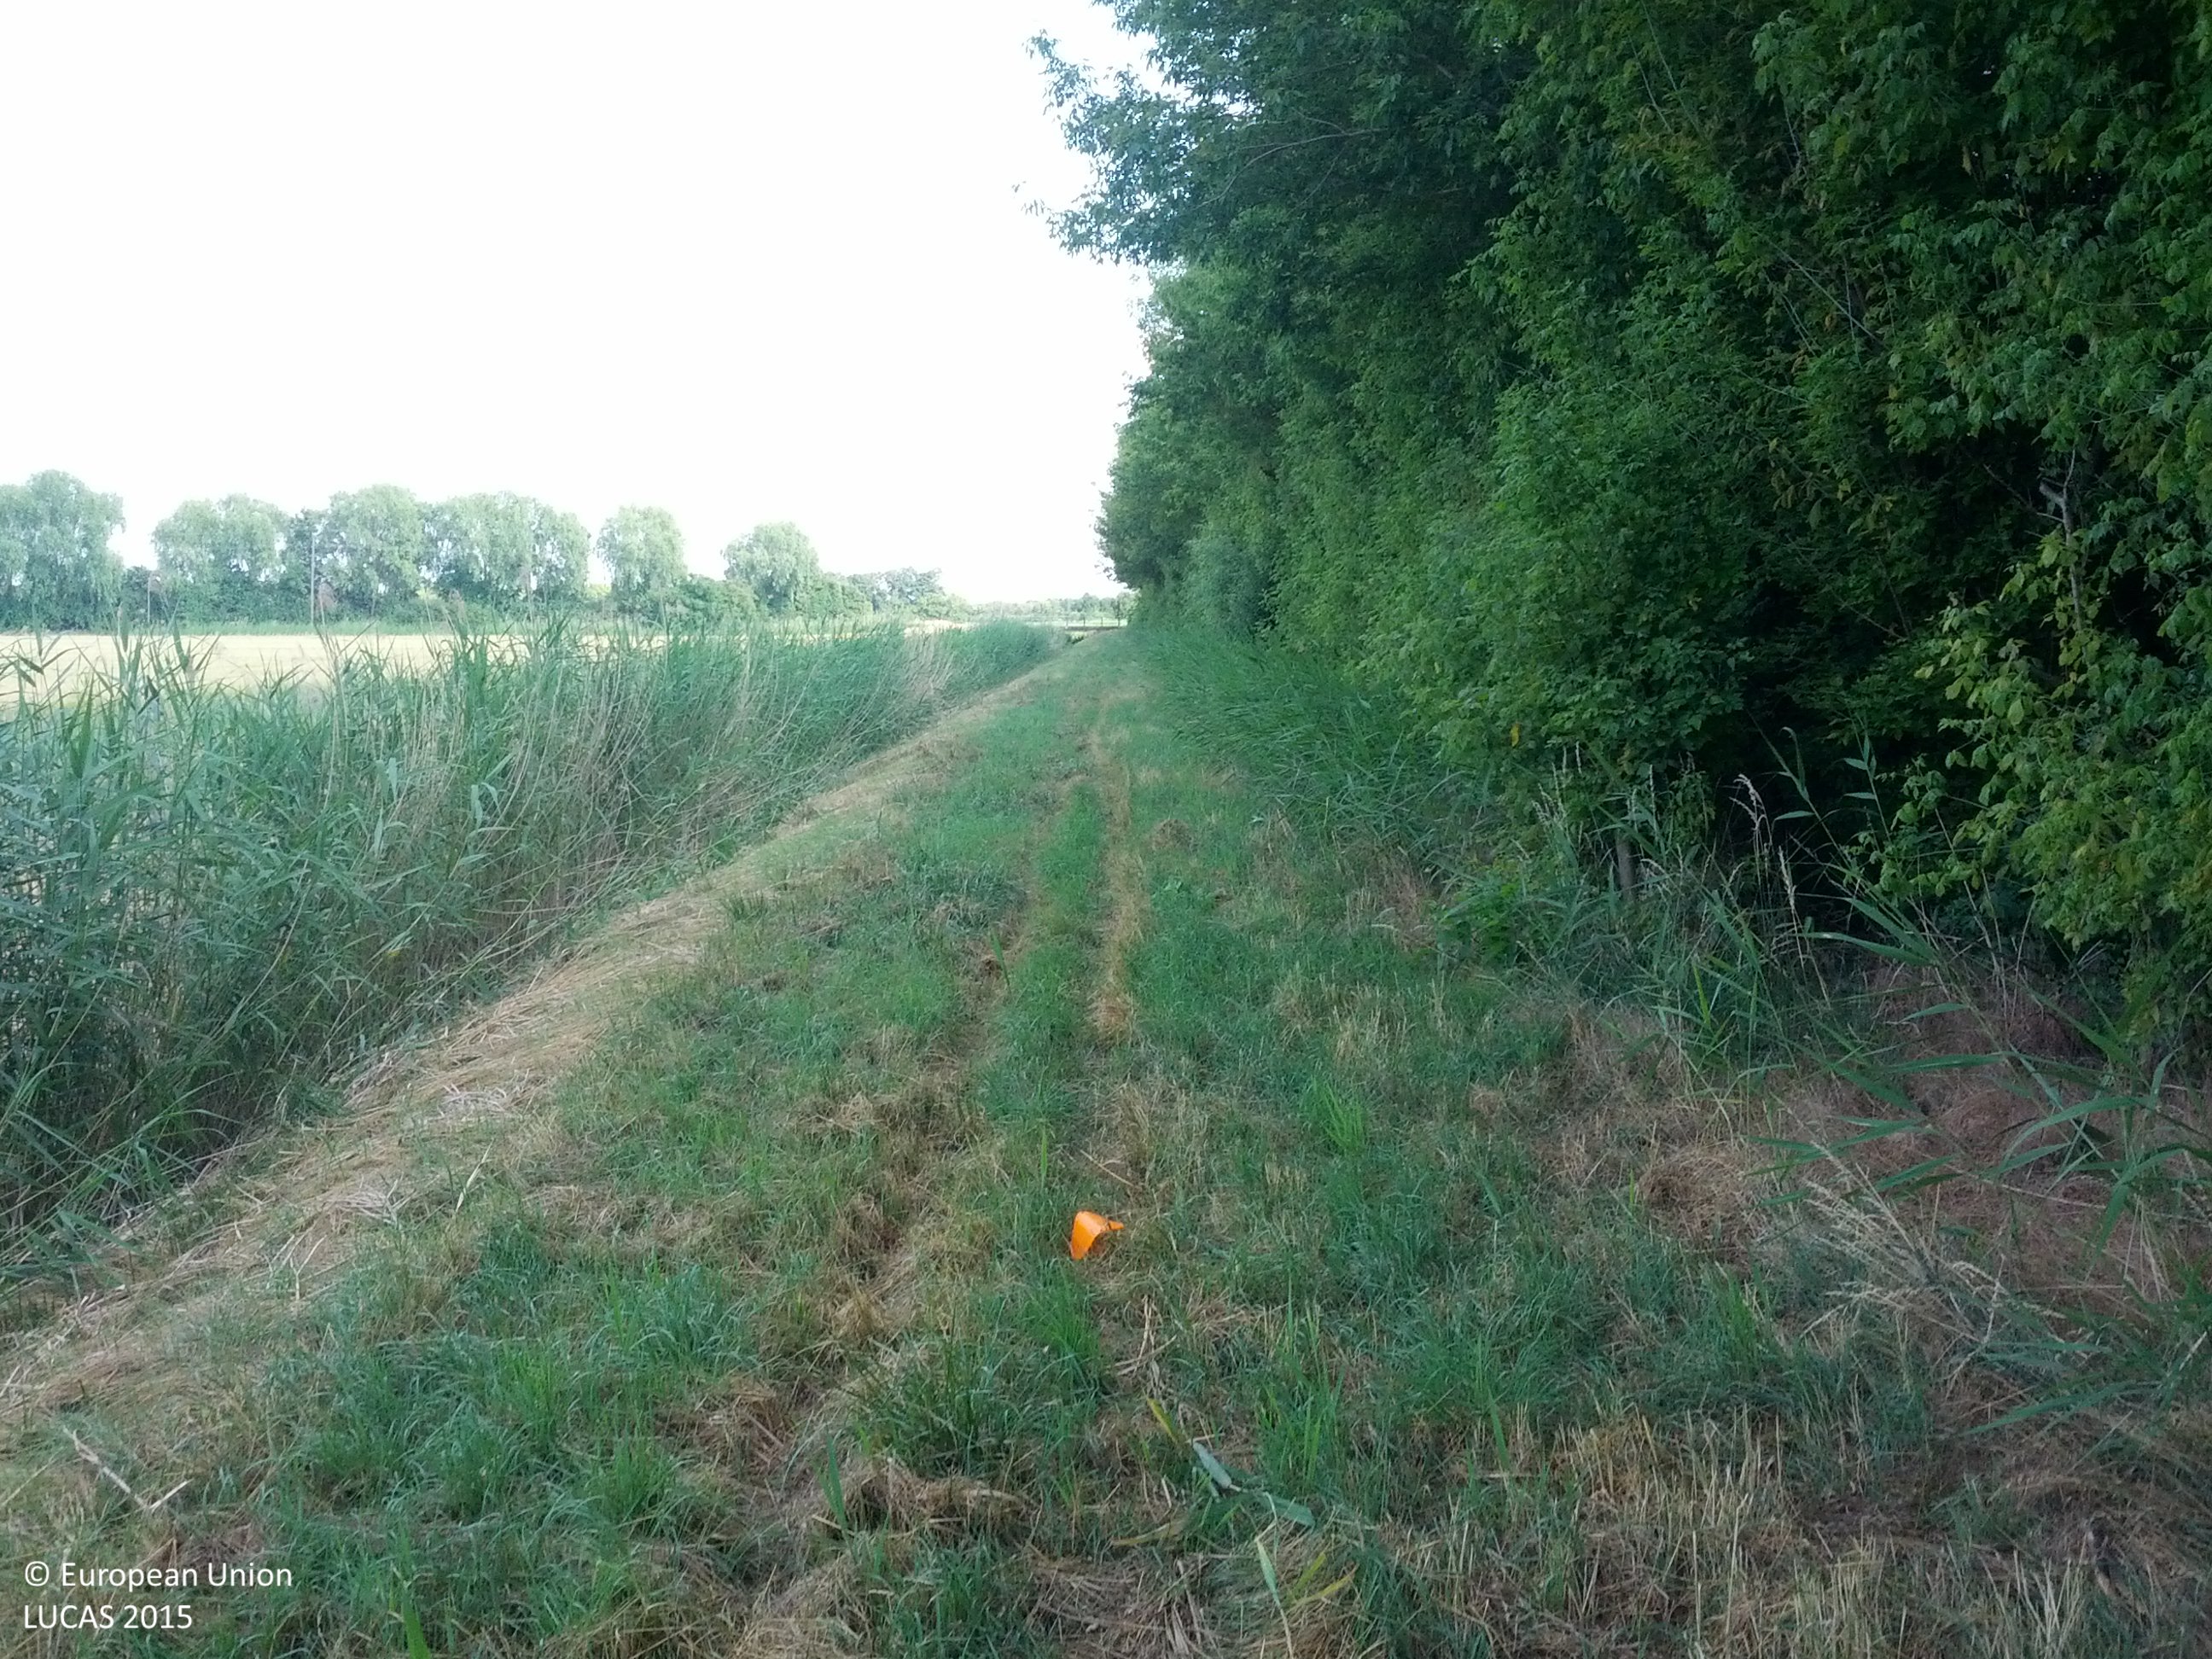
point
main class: Grassland
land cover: Grassland without tree/shrub cover
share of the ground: > 75 %
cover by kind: herbaceous plants 100 %
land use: Semi-natural and natural areas not in use
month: July
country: AT
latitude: 48.5896
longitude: 16.8270
